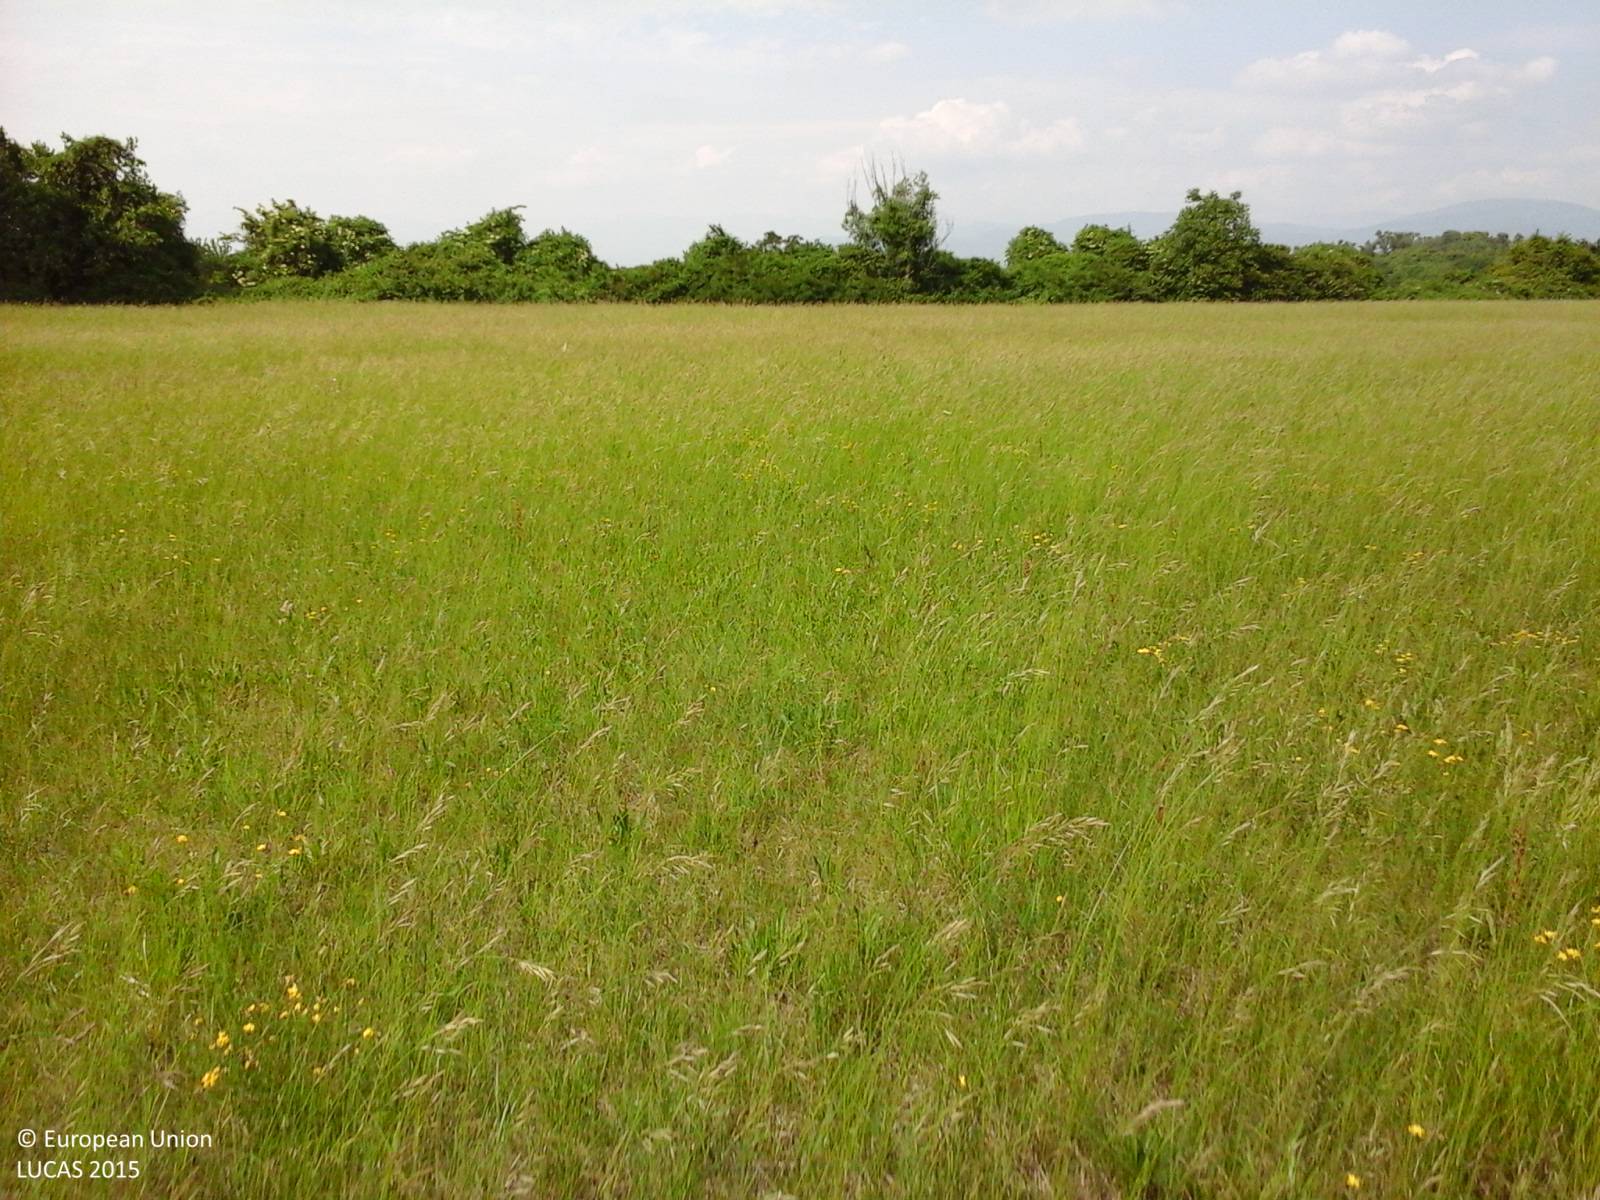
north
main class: Grassland
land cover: Grassland without tree/shrub cover
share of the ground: > 75 %
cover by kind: herbaceous plants 100 %
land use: Agriculture (excluding fallow land and kitchen gardens)
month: May
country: IT
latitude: 46.0474
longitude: 13.3177
